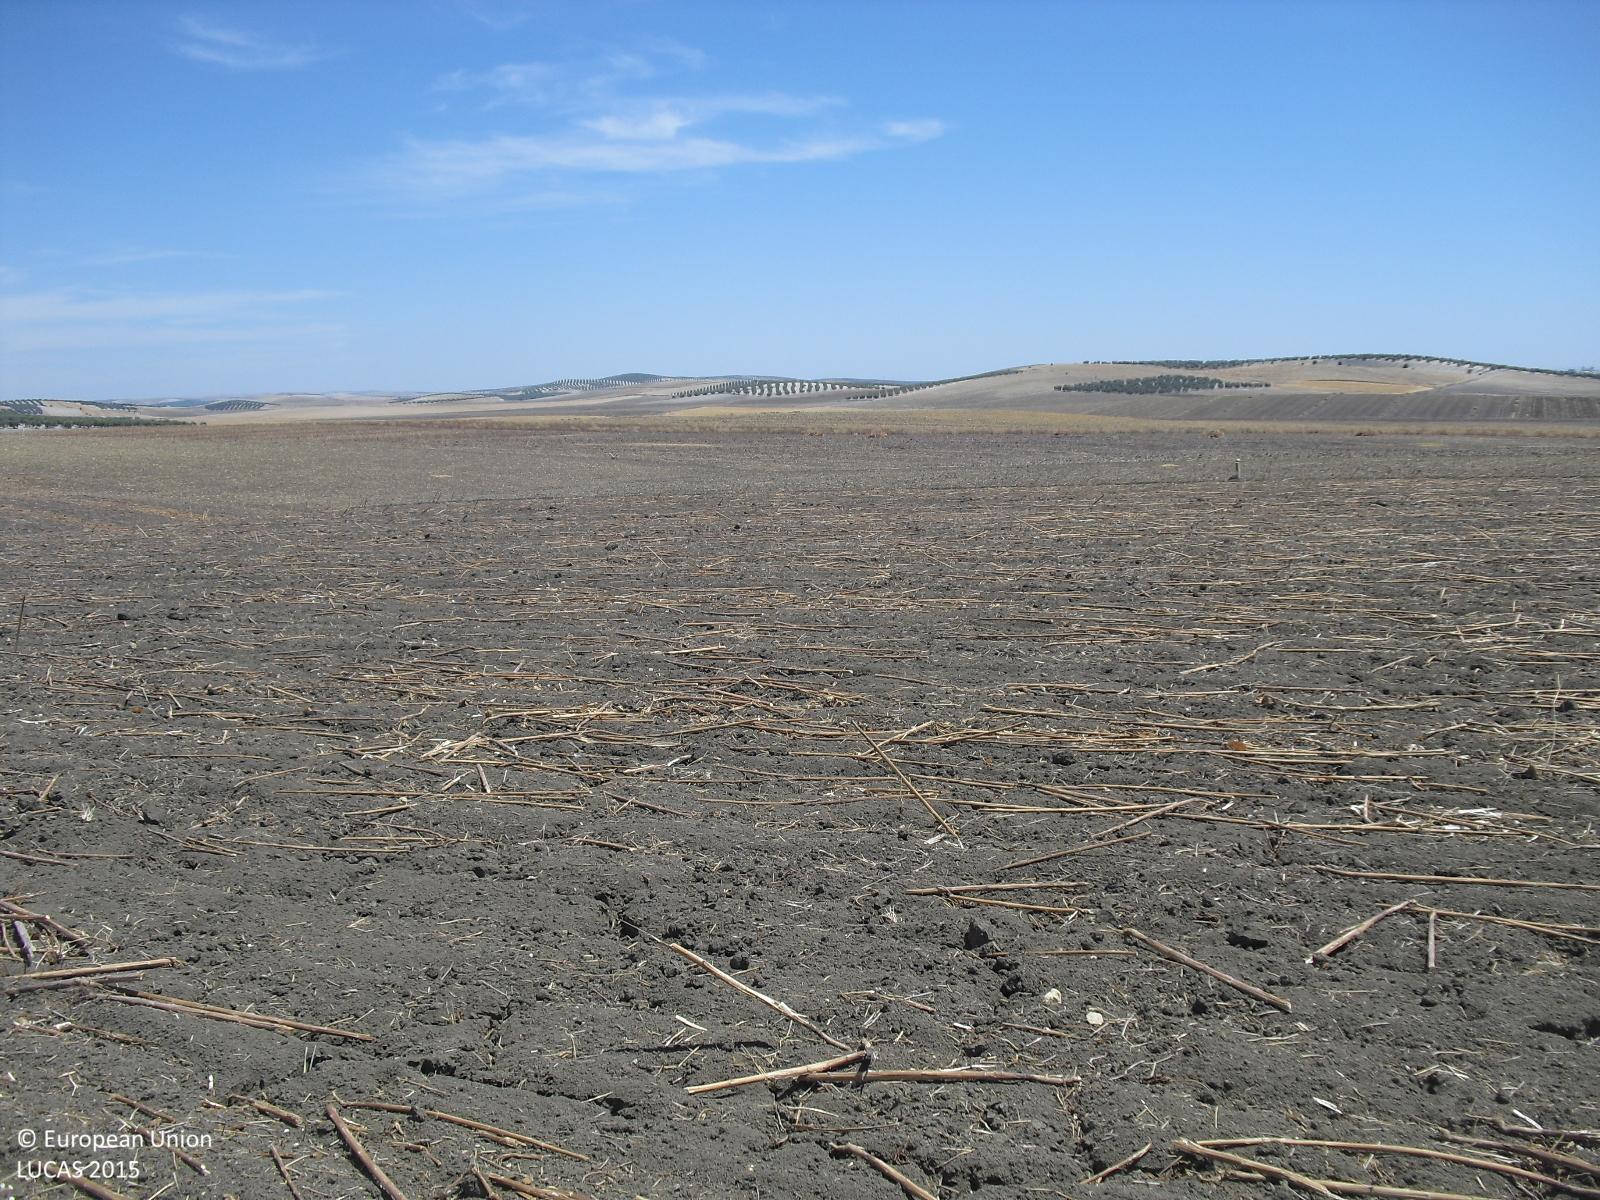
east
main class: Cropland
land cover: Sunflower
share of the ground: < 10 %
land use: Agriculture (excluding fallow land and kitchen gardens)
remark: Harvested field
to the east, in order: Sunflower; Other bare soil; Sunflower
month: August
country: ES
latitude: 37.3537
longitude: -5.4931
